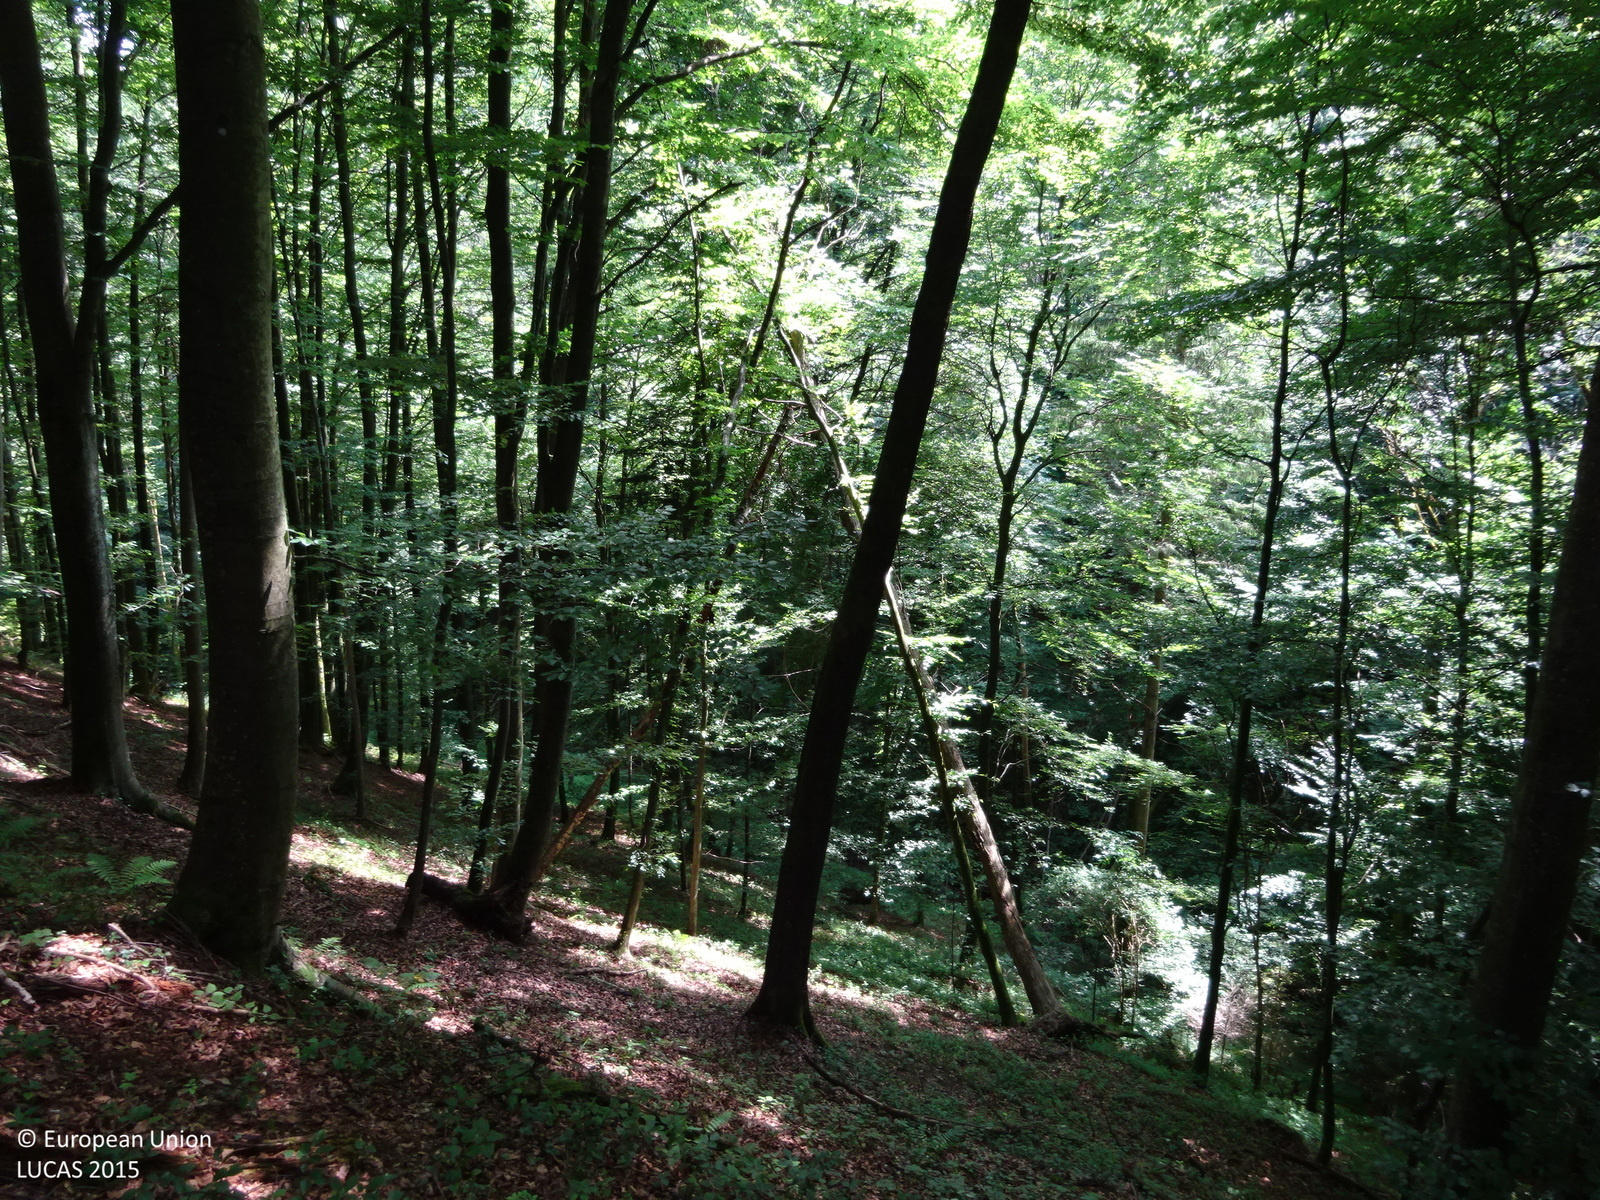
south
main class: Woodland
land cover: Broadleaved woodland
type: mountainous beech forest
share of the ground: > 75 %
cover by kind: broadleaved forest trees 100 %
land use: Forestry
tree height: > 5 m
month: July
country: AT
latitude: 46.7906
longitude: 15.4358
